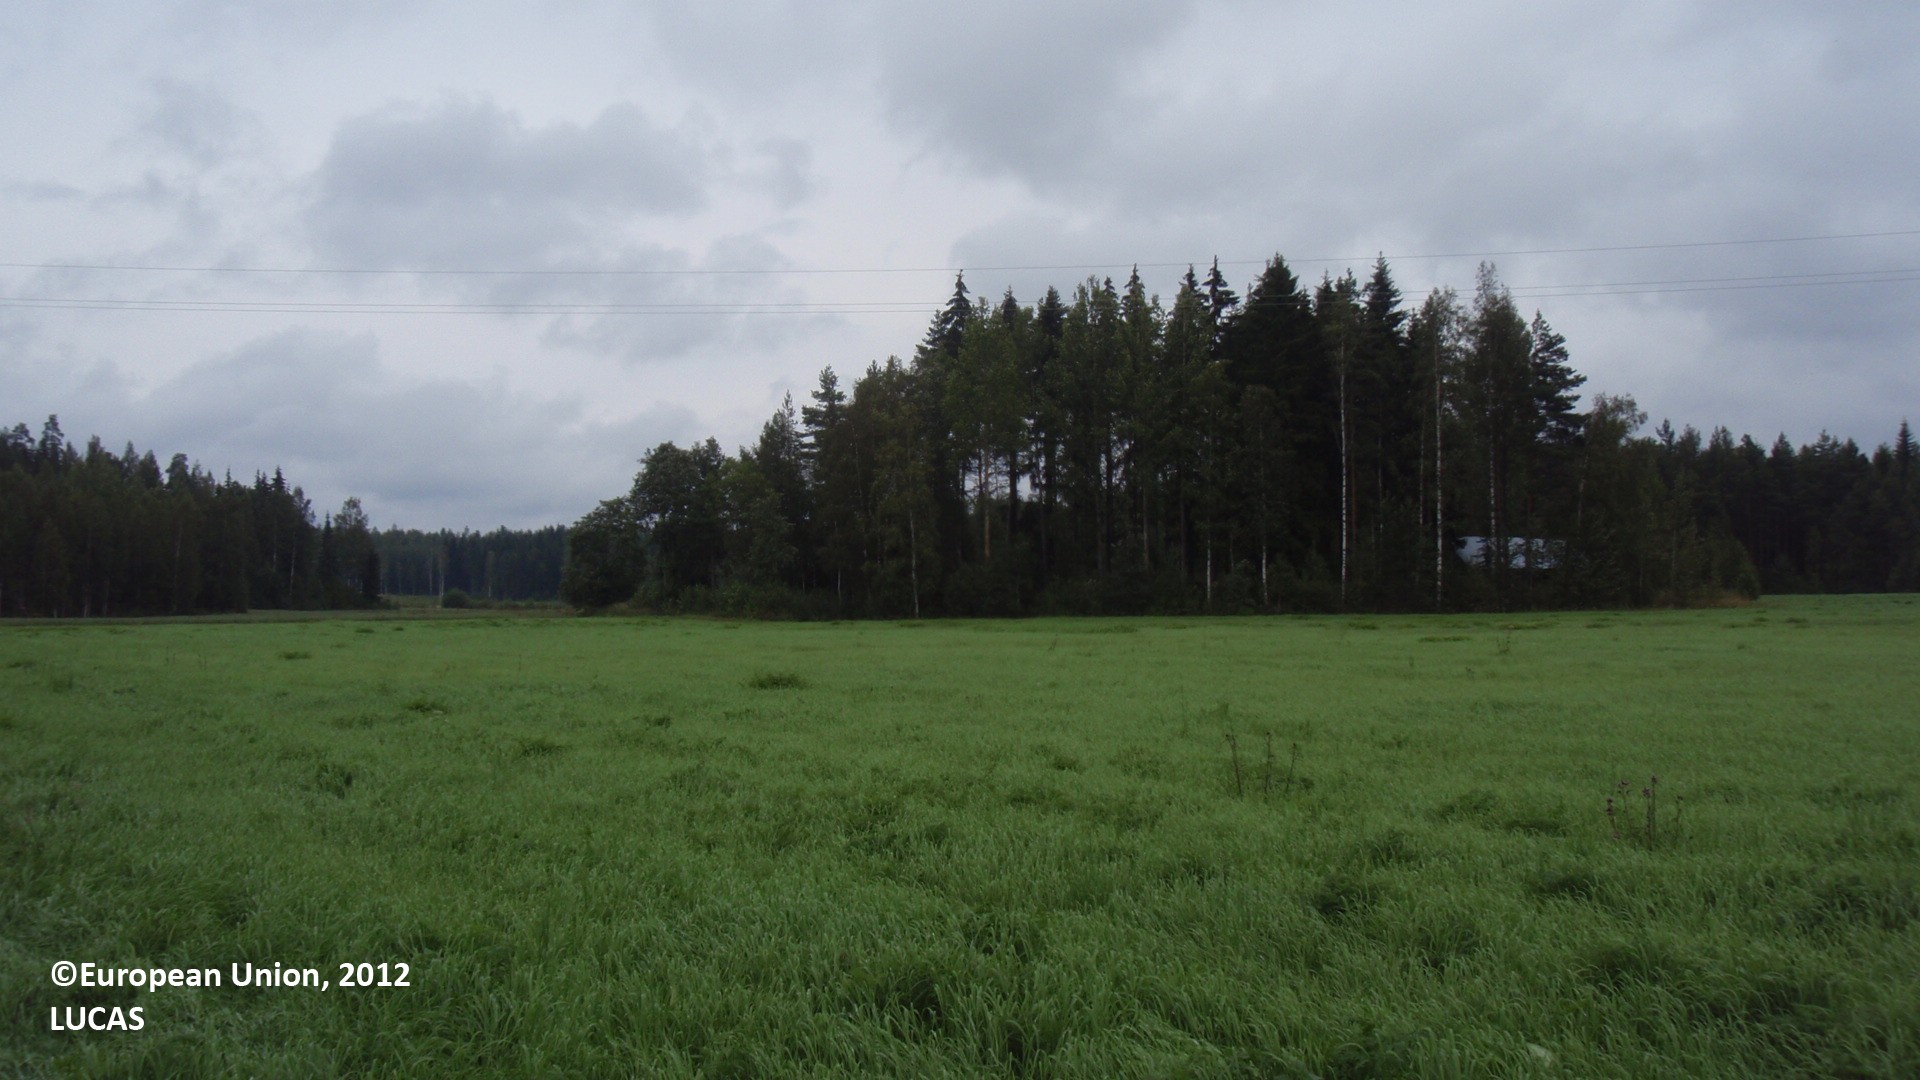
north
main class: Cropland
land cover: Temporary grasslands
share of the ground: > 75 %
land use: Agriculture (excluding fallow land and kitchen gardens)
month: August
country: FI
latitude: 61.0854
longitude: 27.0963
